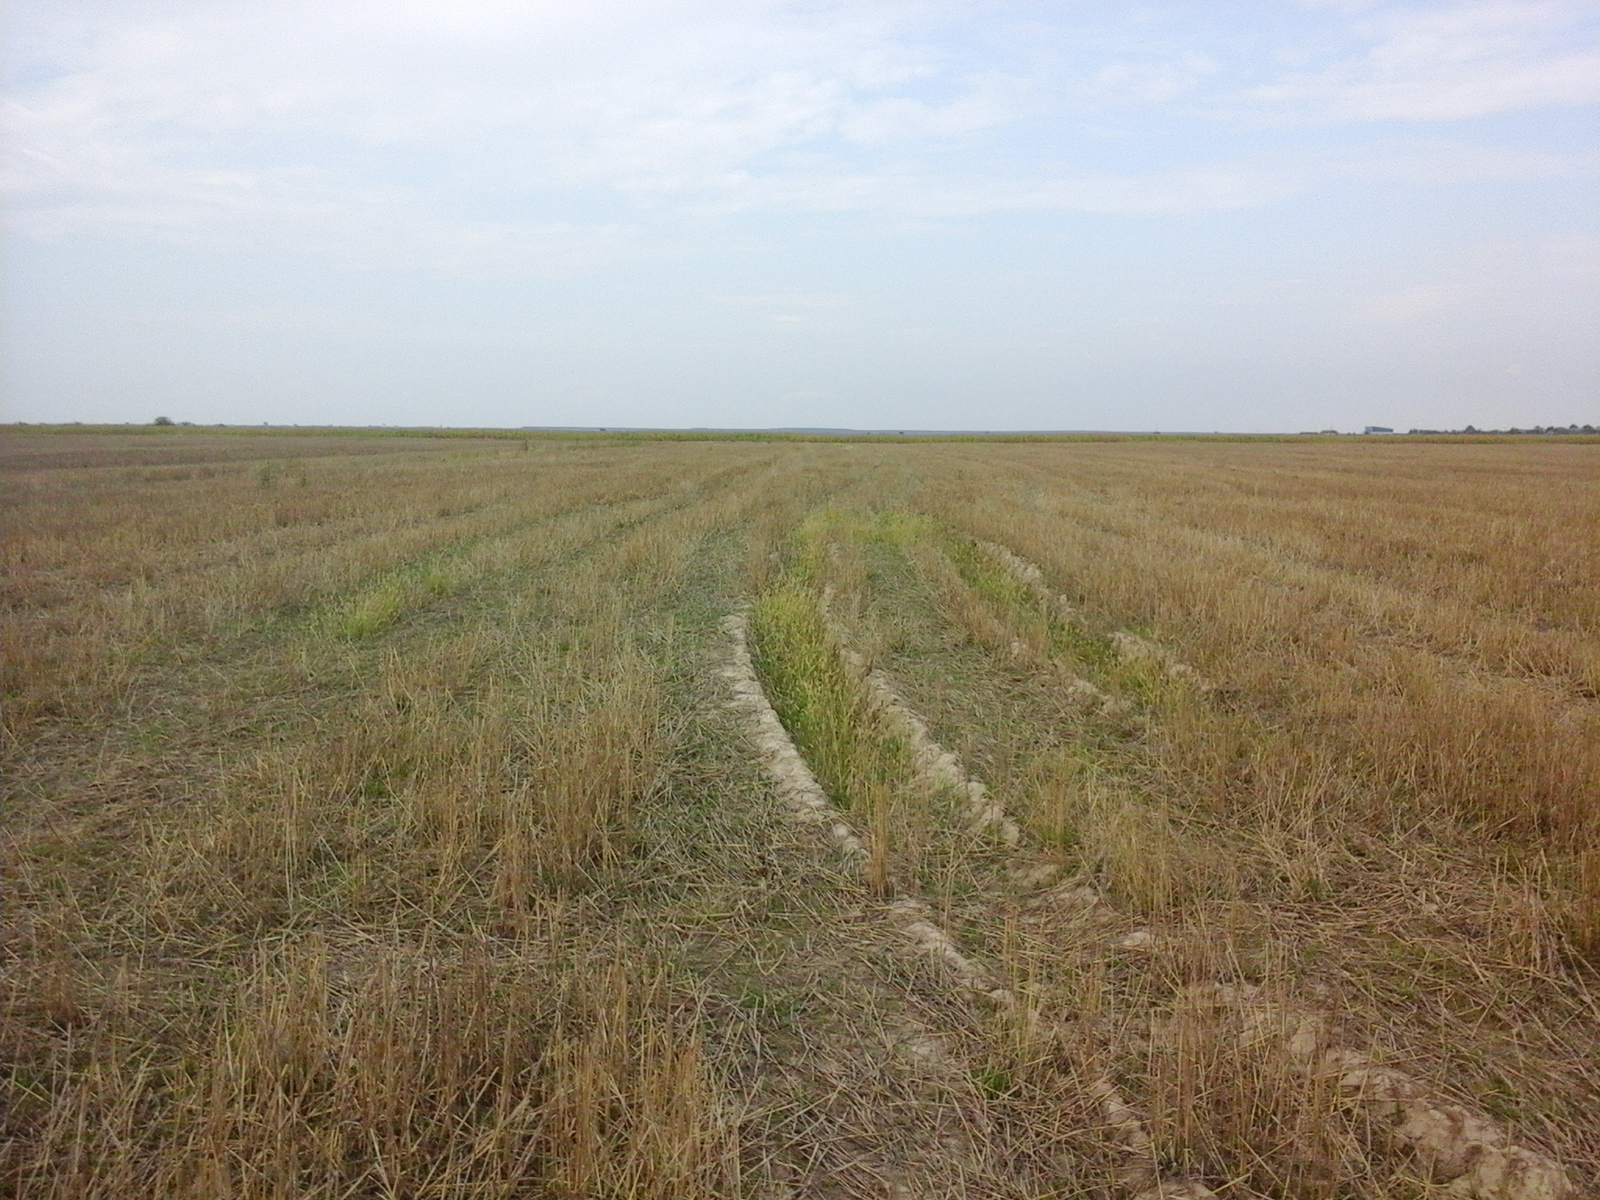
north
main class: Cropland
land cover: Common wheat
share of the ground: 25 - 50 %
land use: Agriculture (excluding fallow land and kitchen gardens)
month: August
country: RO
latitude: 46.6257
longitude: 21.9422
